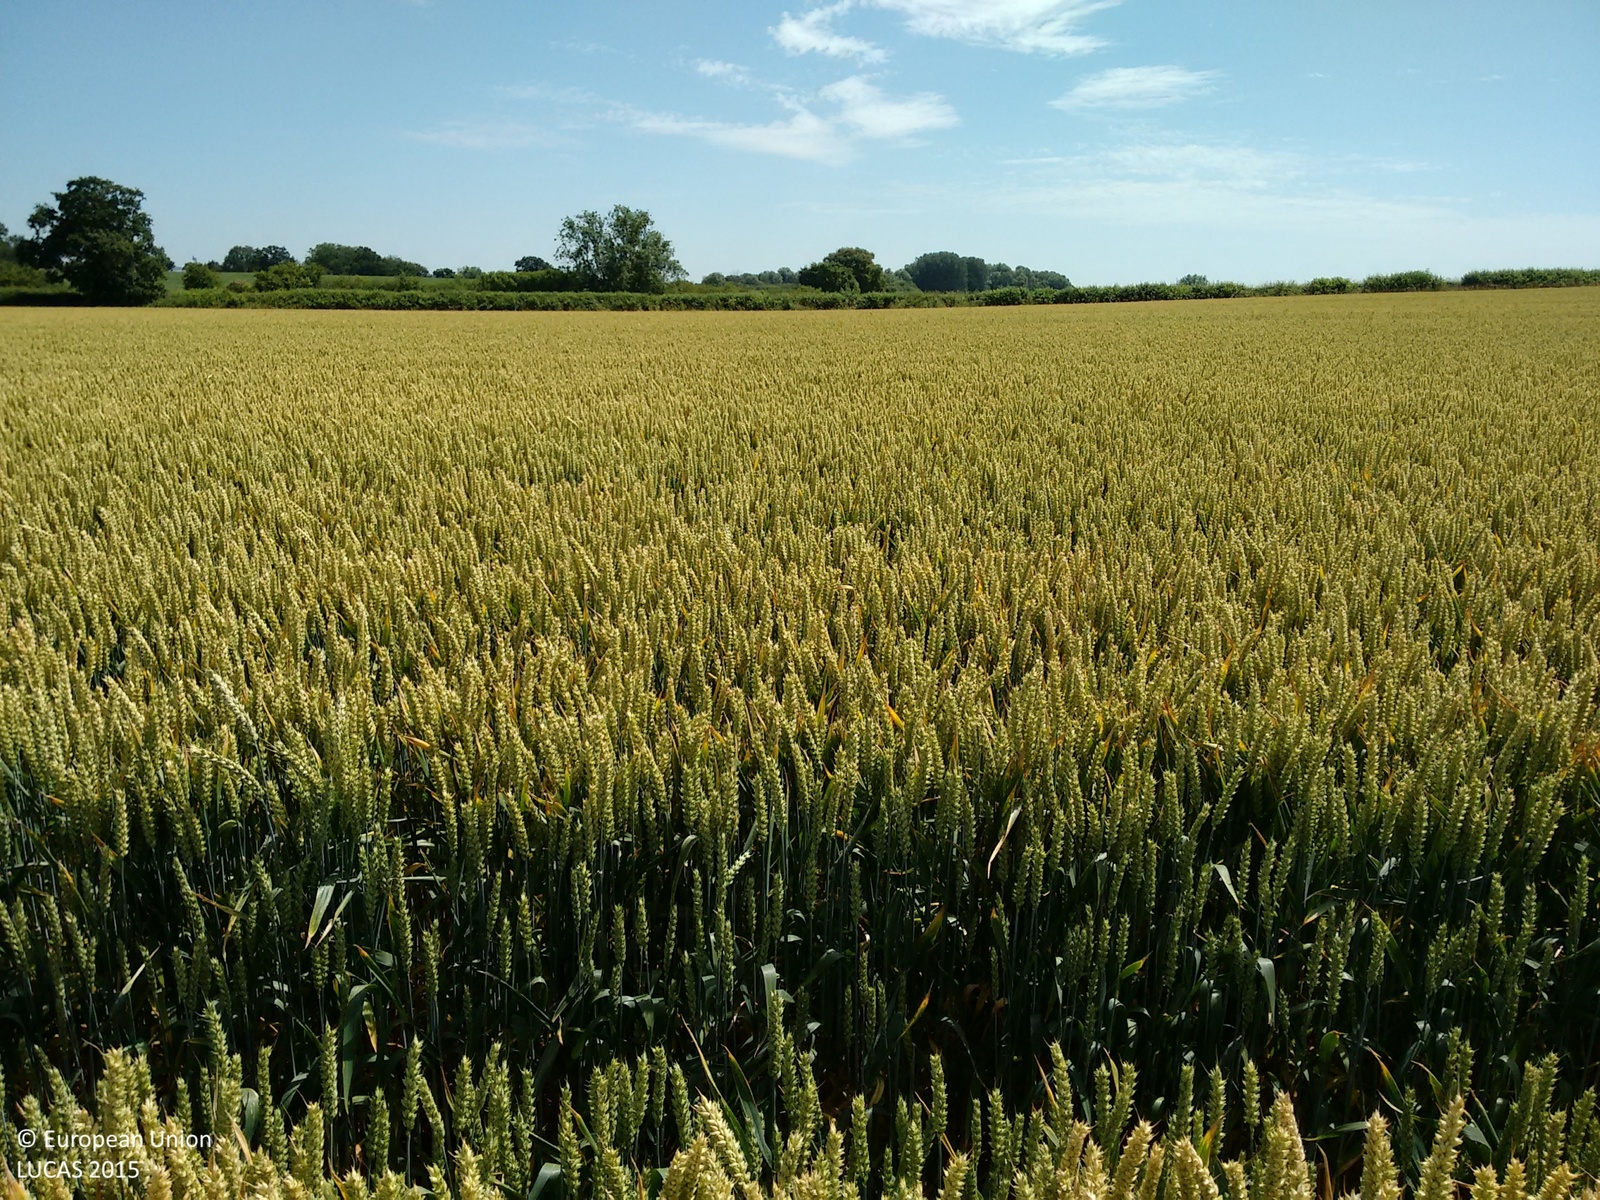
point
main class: Cropland
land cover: Common wheat
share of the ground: > 75 %
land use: Agriculture (excluding fallow land and kitchen gardens)
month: July
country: GB
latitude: 51.6851
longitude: -1.1697
